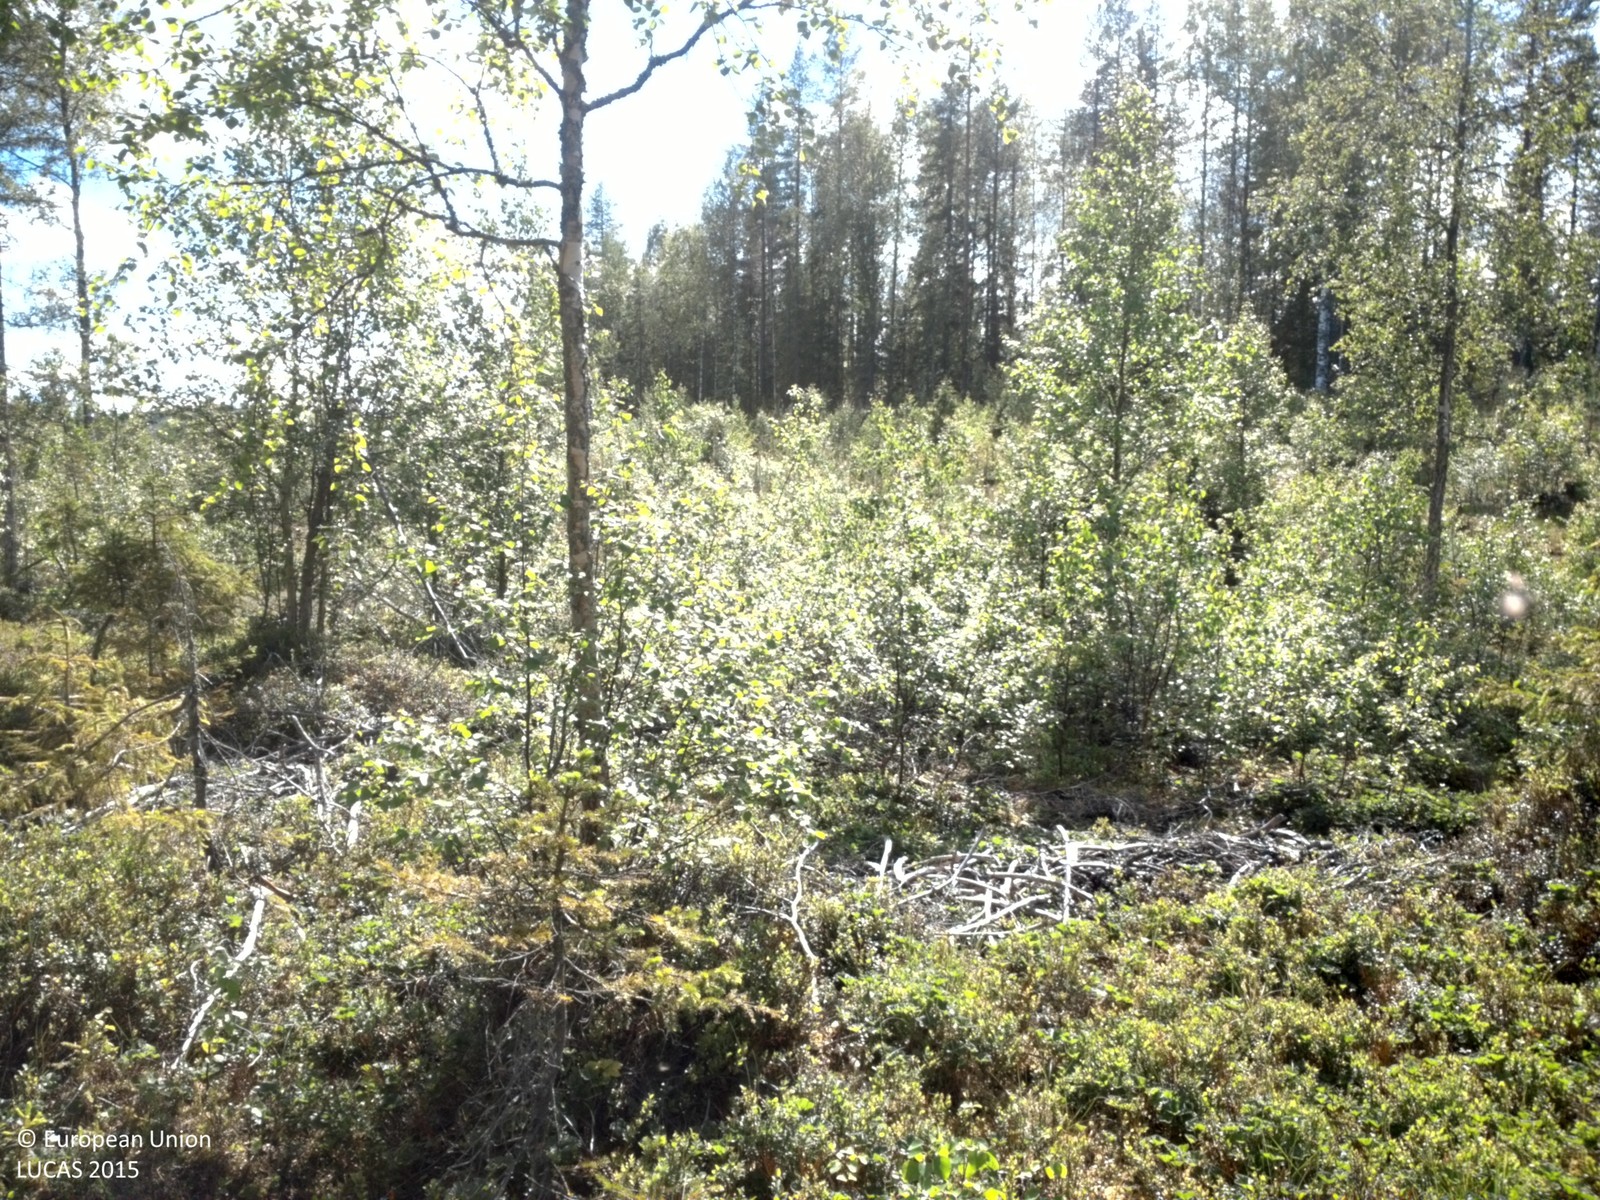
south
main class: Woodland
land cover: Other mixed woodland
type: boreal forest
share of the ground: 25 - 50 %
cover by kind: shrubs 50 %, coniferous forest trees 30 %, broadleaved forest trees 10 %, lichens and mosses 10 %
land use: Forestry
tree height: > 5 m
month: July
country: SE
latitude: 64.4005
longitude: 20.7038
